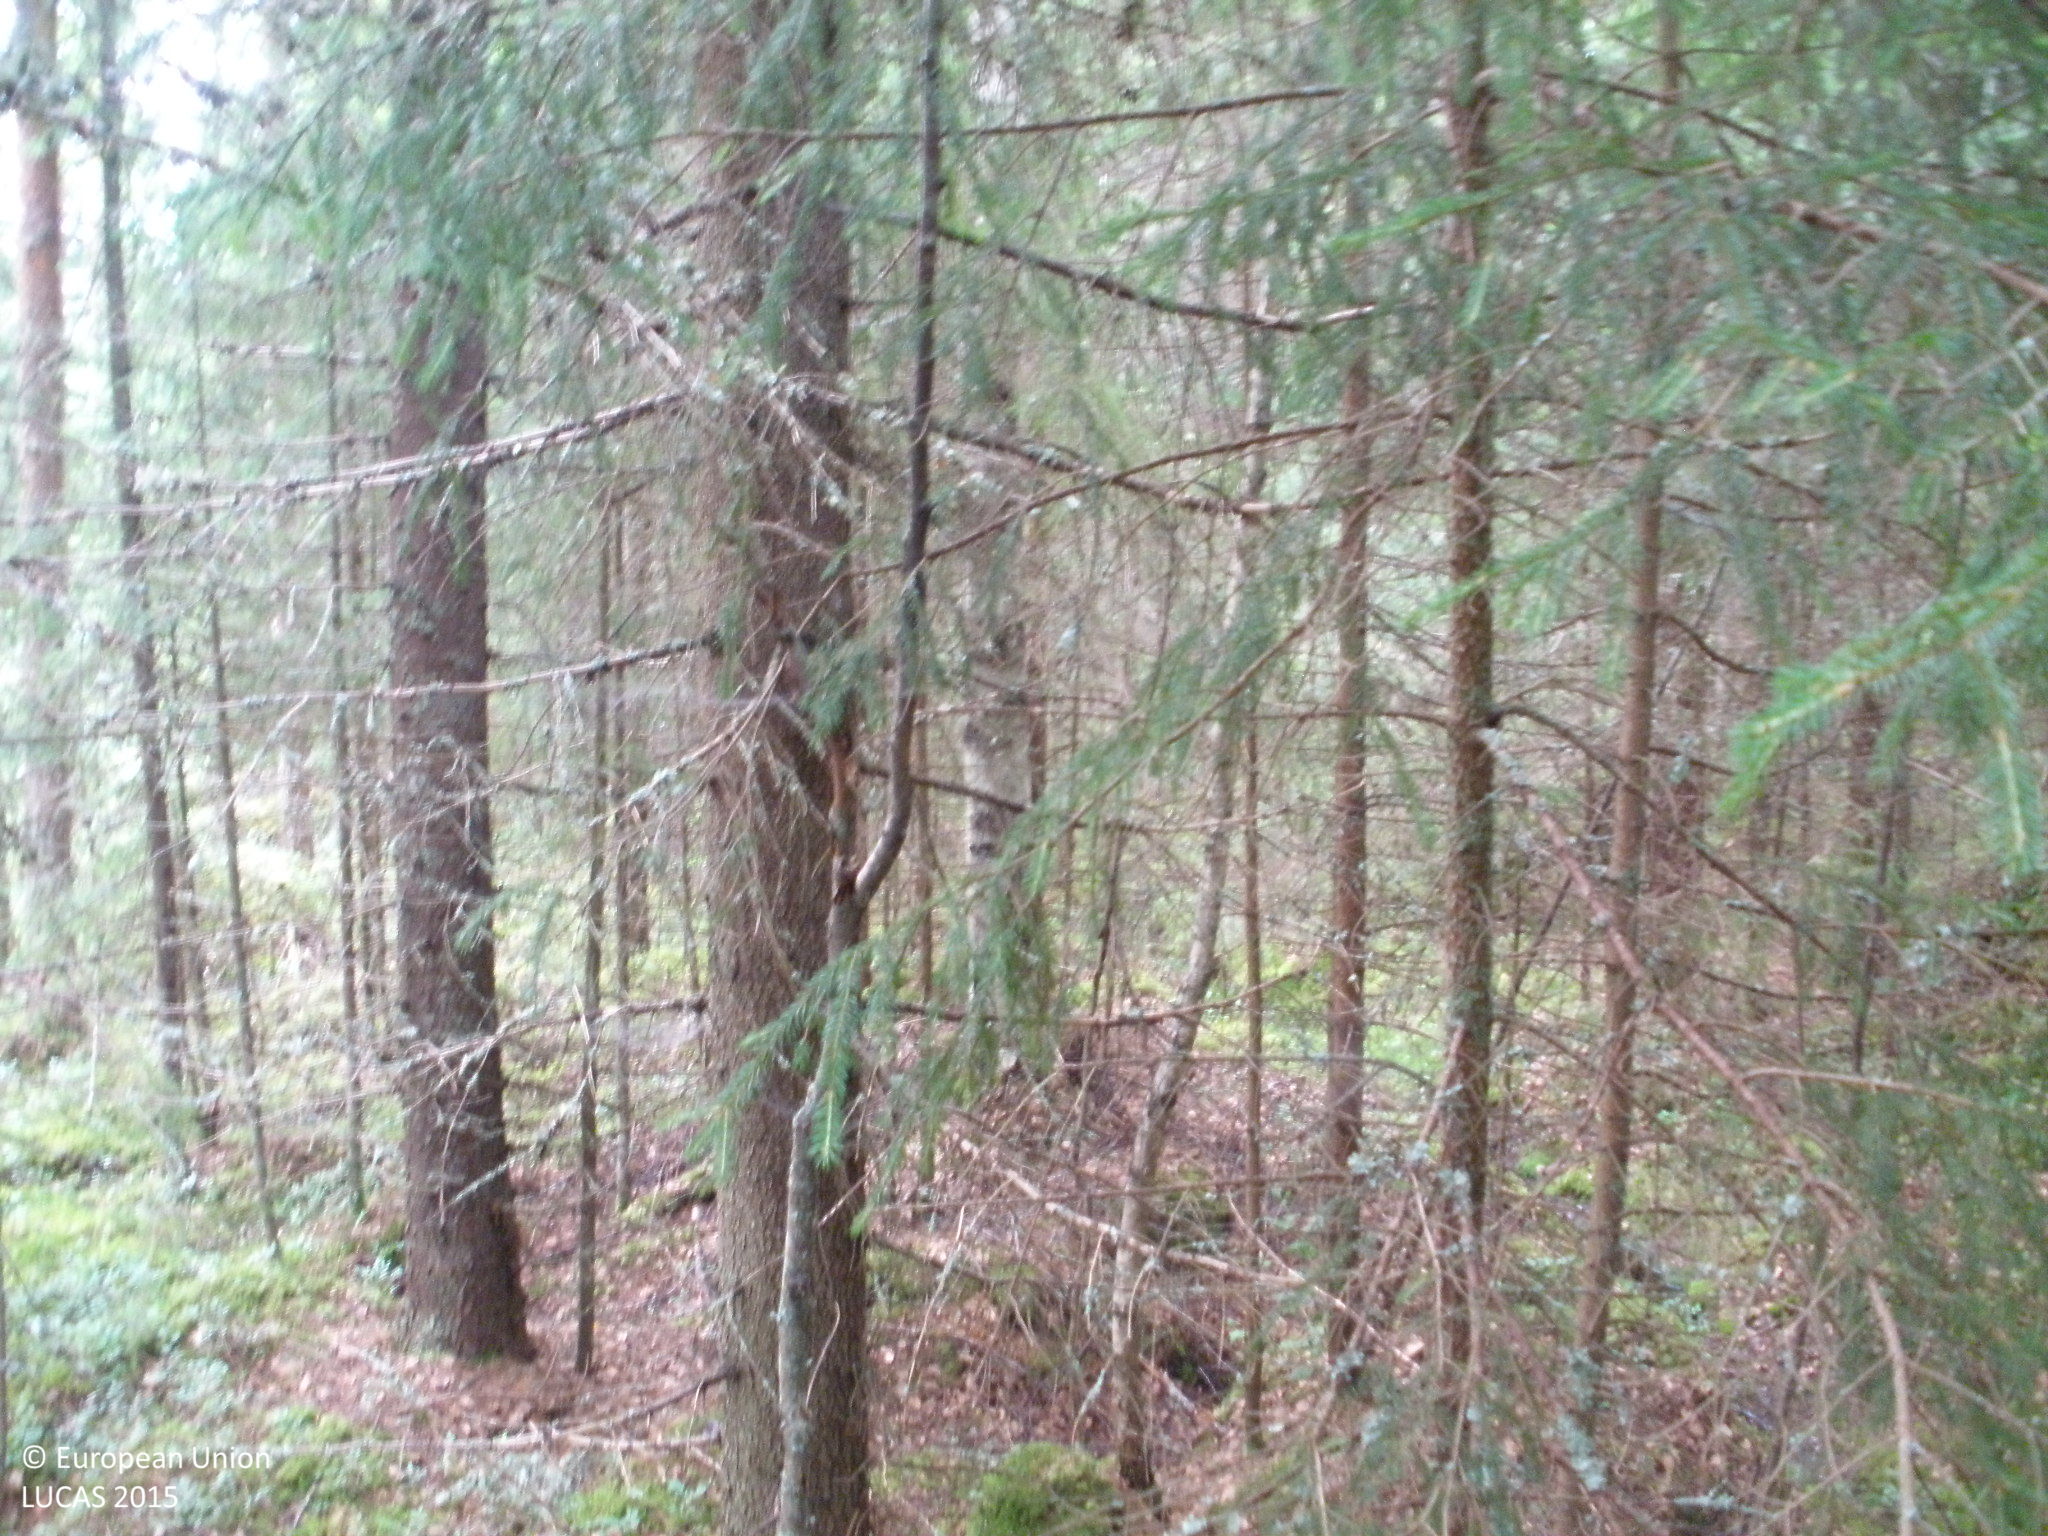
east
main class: Woodland
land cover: Spruce dominated mixed woodland
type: boreal forest
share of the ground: > 75 %
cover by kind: coniferous forest trees 60 %, broadleaved forest trees 25 %, herbaceous plants 10 %, lichens and mosses 5 %
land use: Forestry
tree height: > 5 m
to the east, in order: Spruce dominated mixed woodland; Ditches and canals; Spruce dominated mixed woodland; Grass margins; Tracks; Grass margins; Spruce dominated mixed woodland; Pine dominated coniferous woodland; Spruce dominated mixed woodland; Spruce dominated coniferous woodland; Pine dominated coniferous woodland; Pine dominated mixed woodland; Inland fresh running water; Spruce dominated mixed woodland
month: July
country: FI
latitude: 61.2082
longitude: 25.0211
